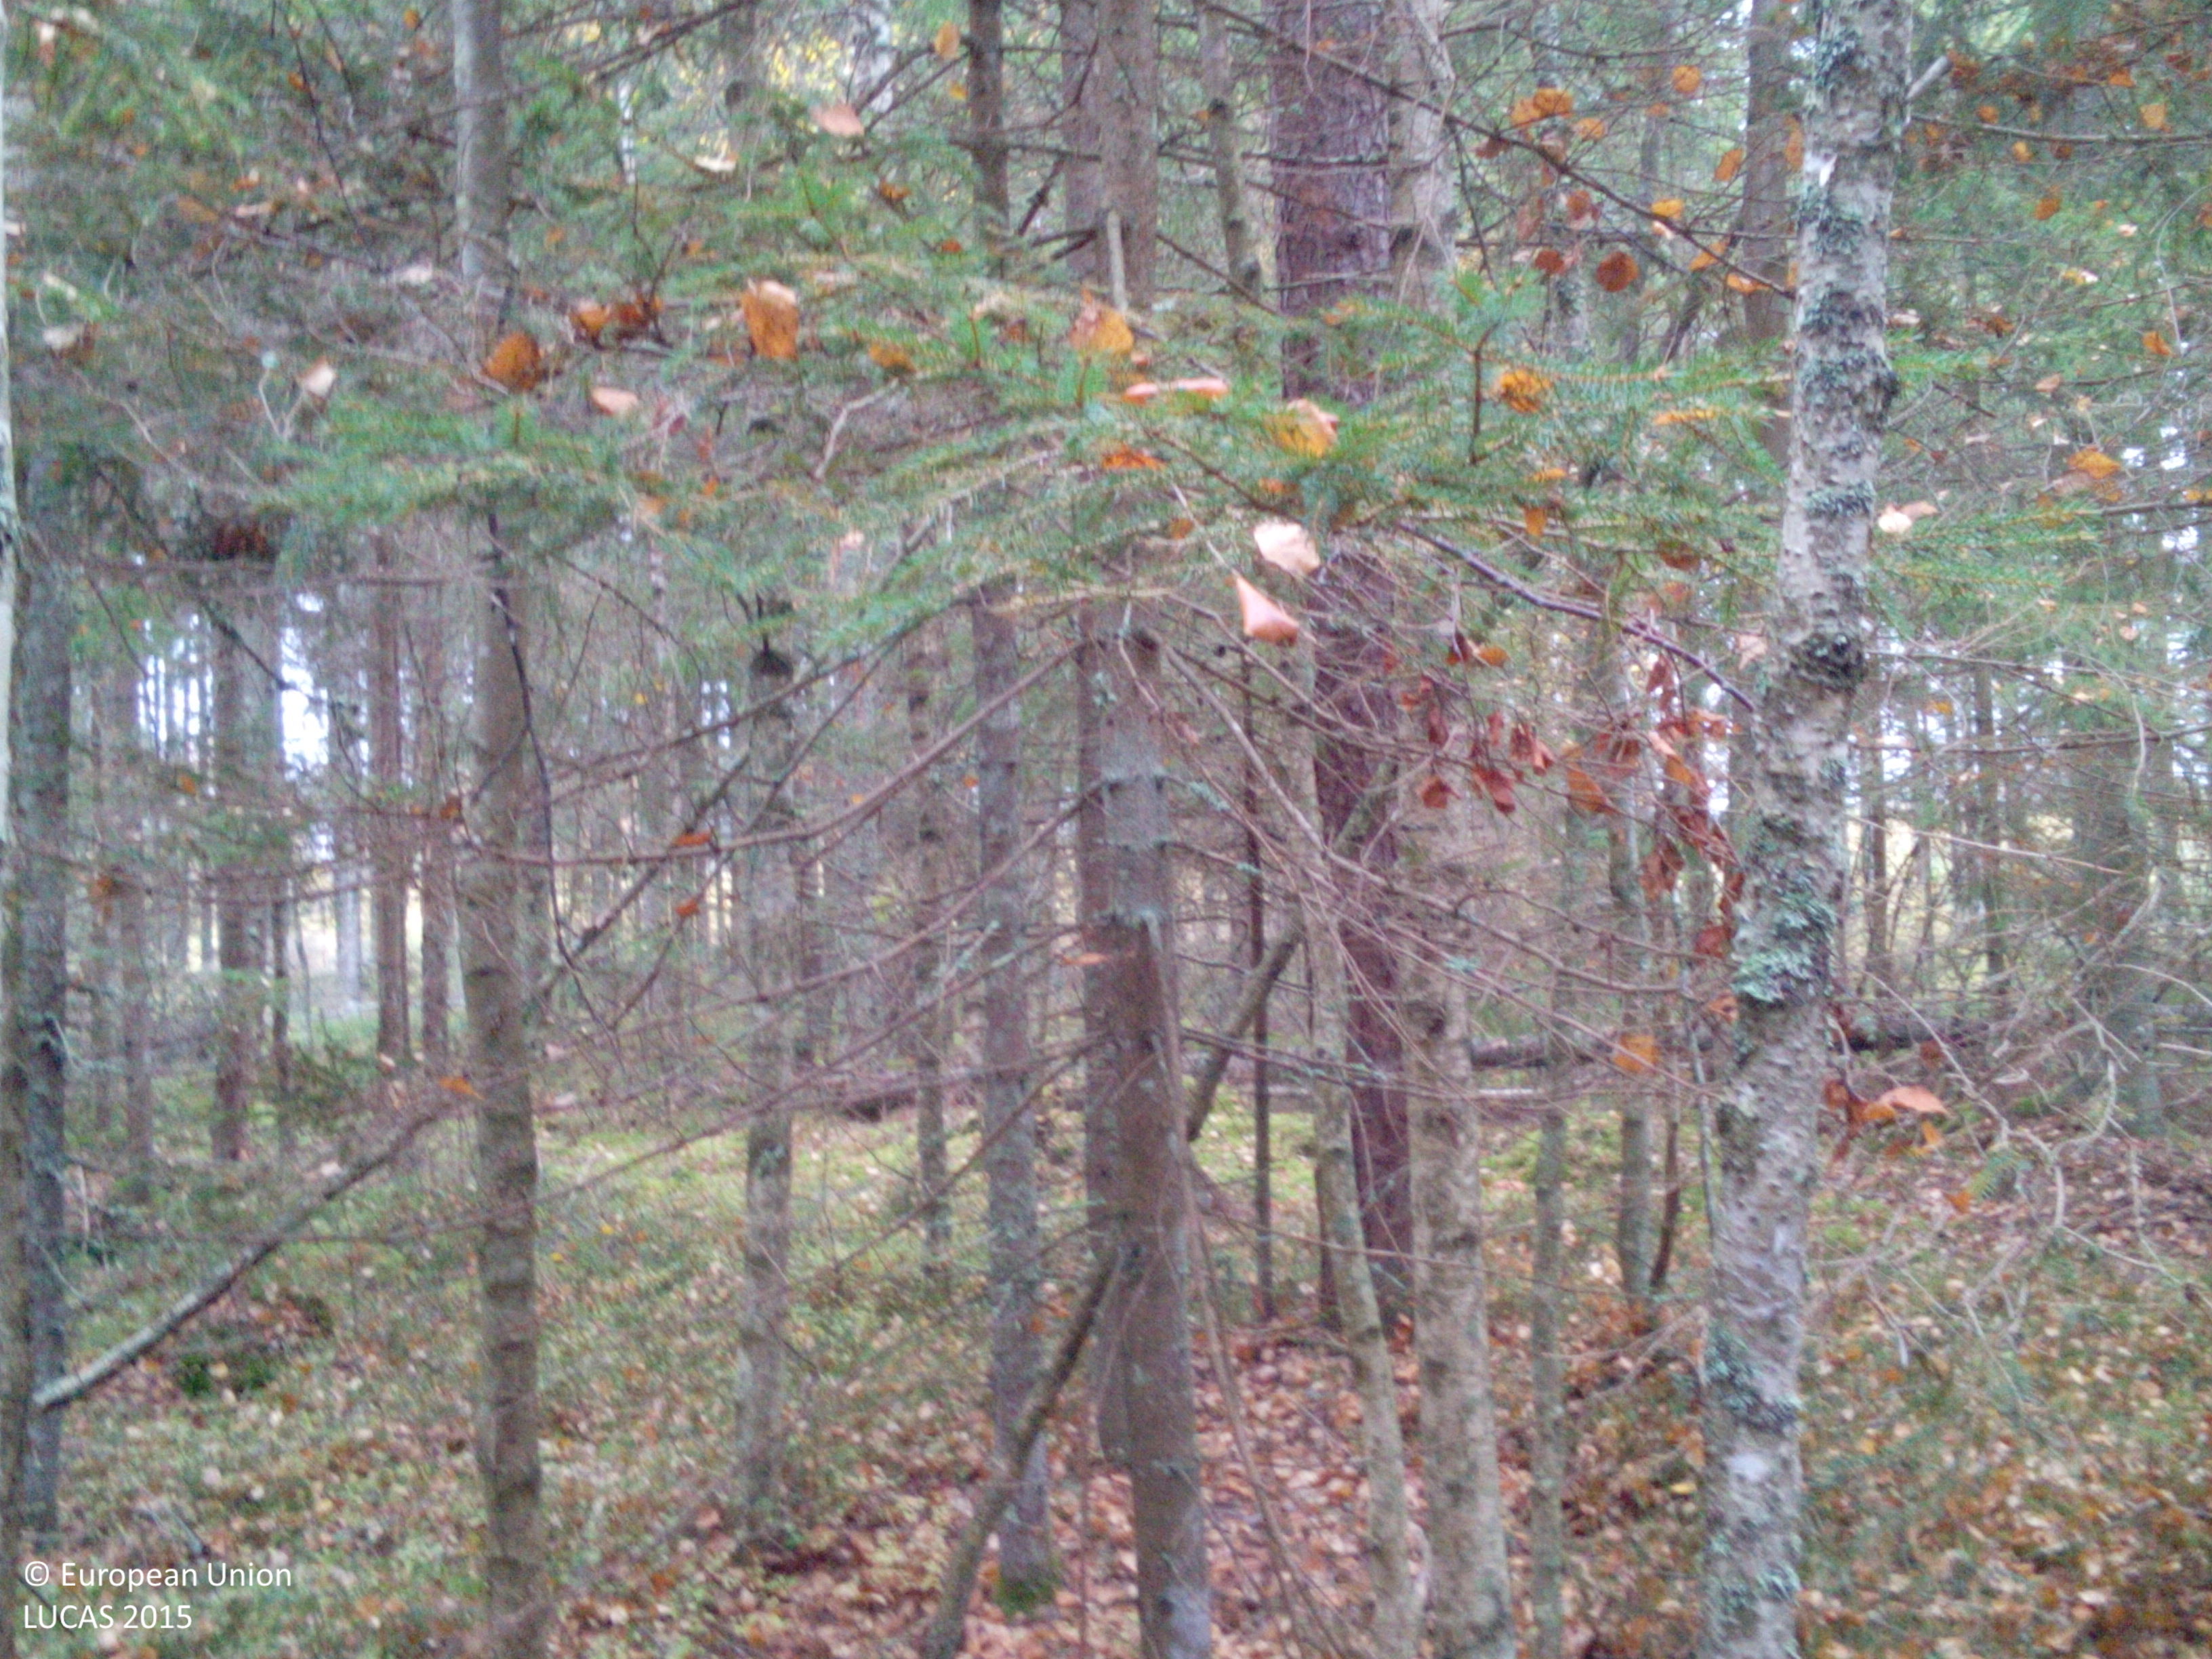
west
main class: Woodland
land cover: Spruce dominated mixed woodland
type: boreal forest
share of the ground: > 75 %
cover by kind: coniferous forest trees 45 %, broadleaved forest trees 40 %, lichens and mosses 10 %, herbaceous plants 5 %
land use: Forestry
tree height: > 5 m
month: October
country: SE
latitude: 59.1057
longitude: 16.1920
